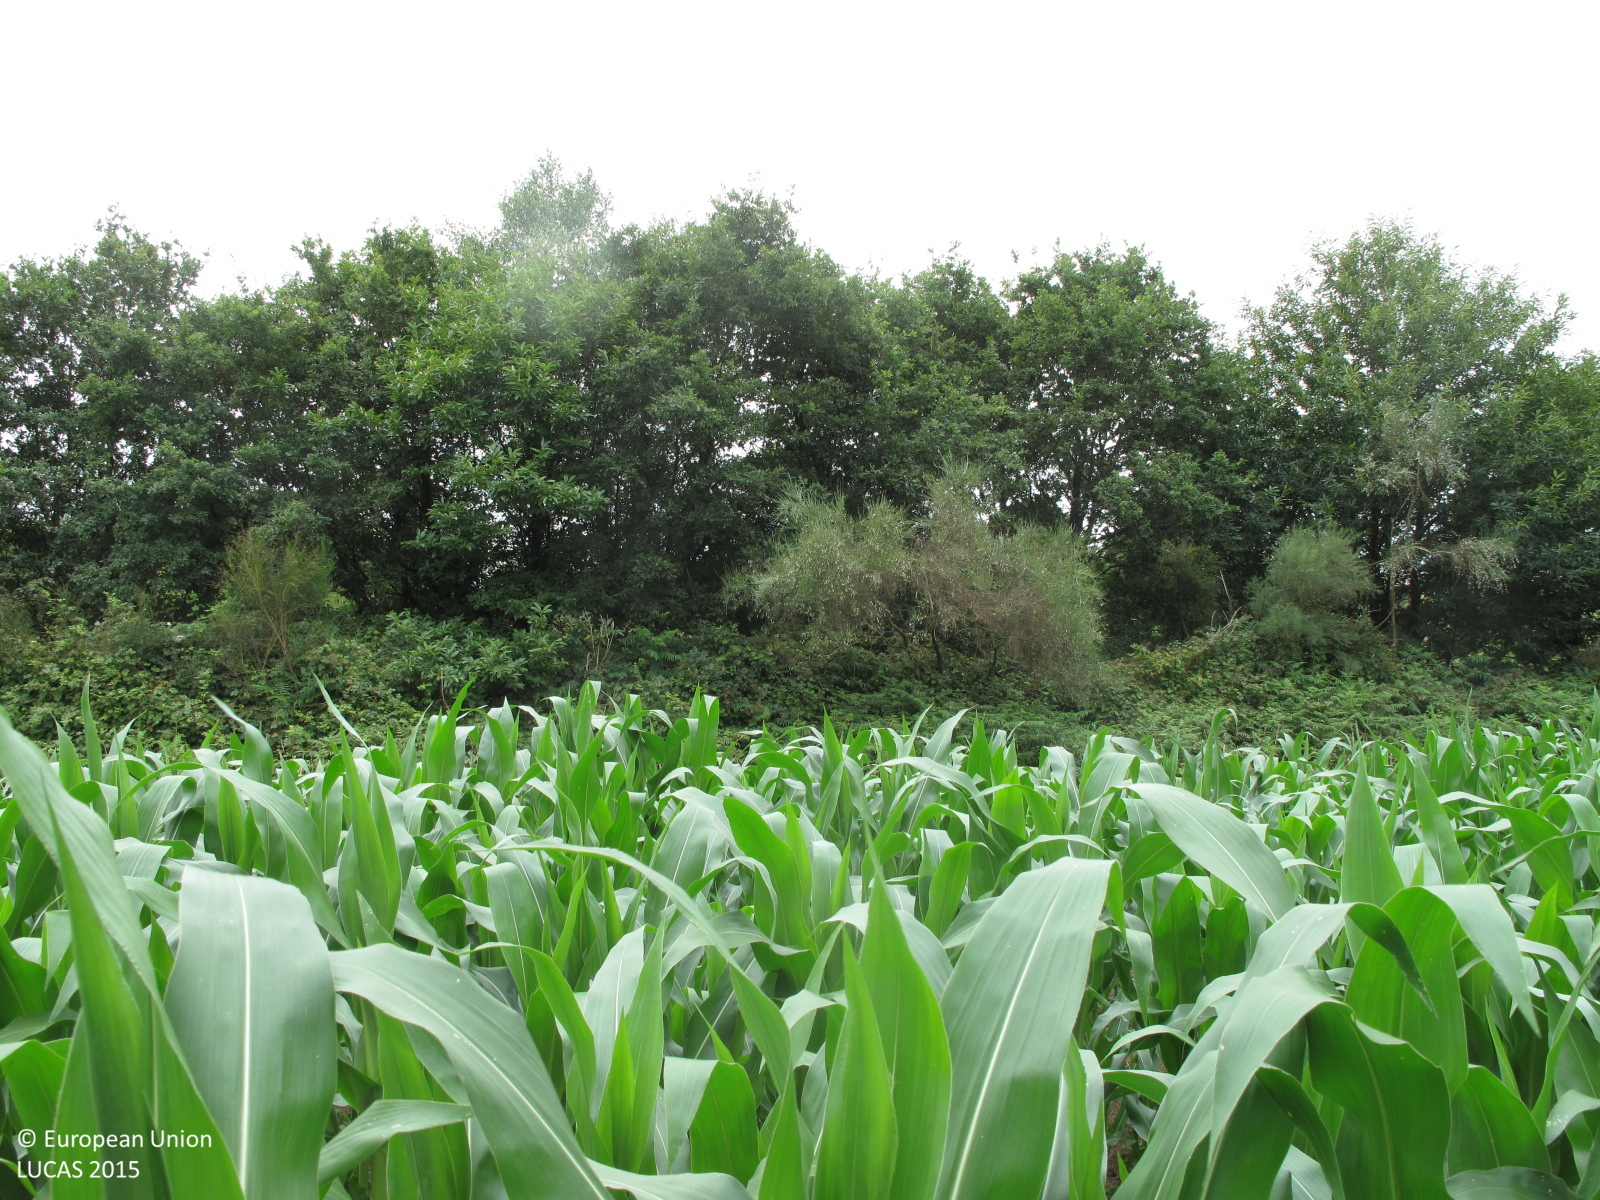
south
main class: Cropland
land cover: Maize
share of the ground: > 75 %
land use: Agriculture (excluding fallow land and kitchen gardens)
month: July
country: ES
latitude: 43.1380
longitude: -8.0552
